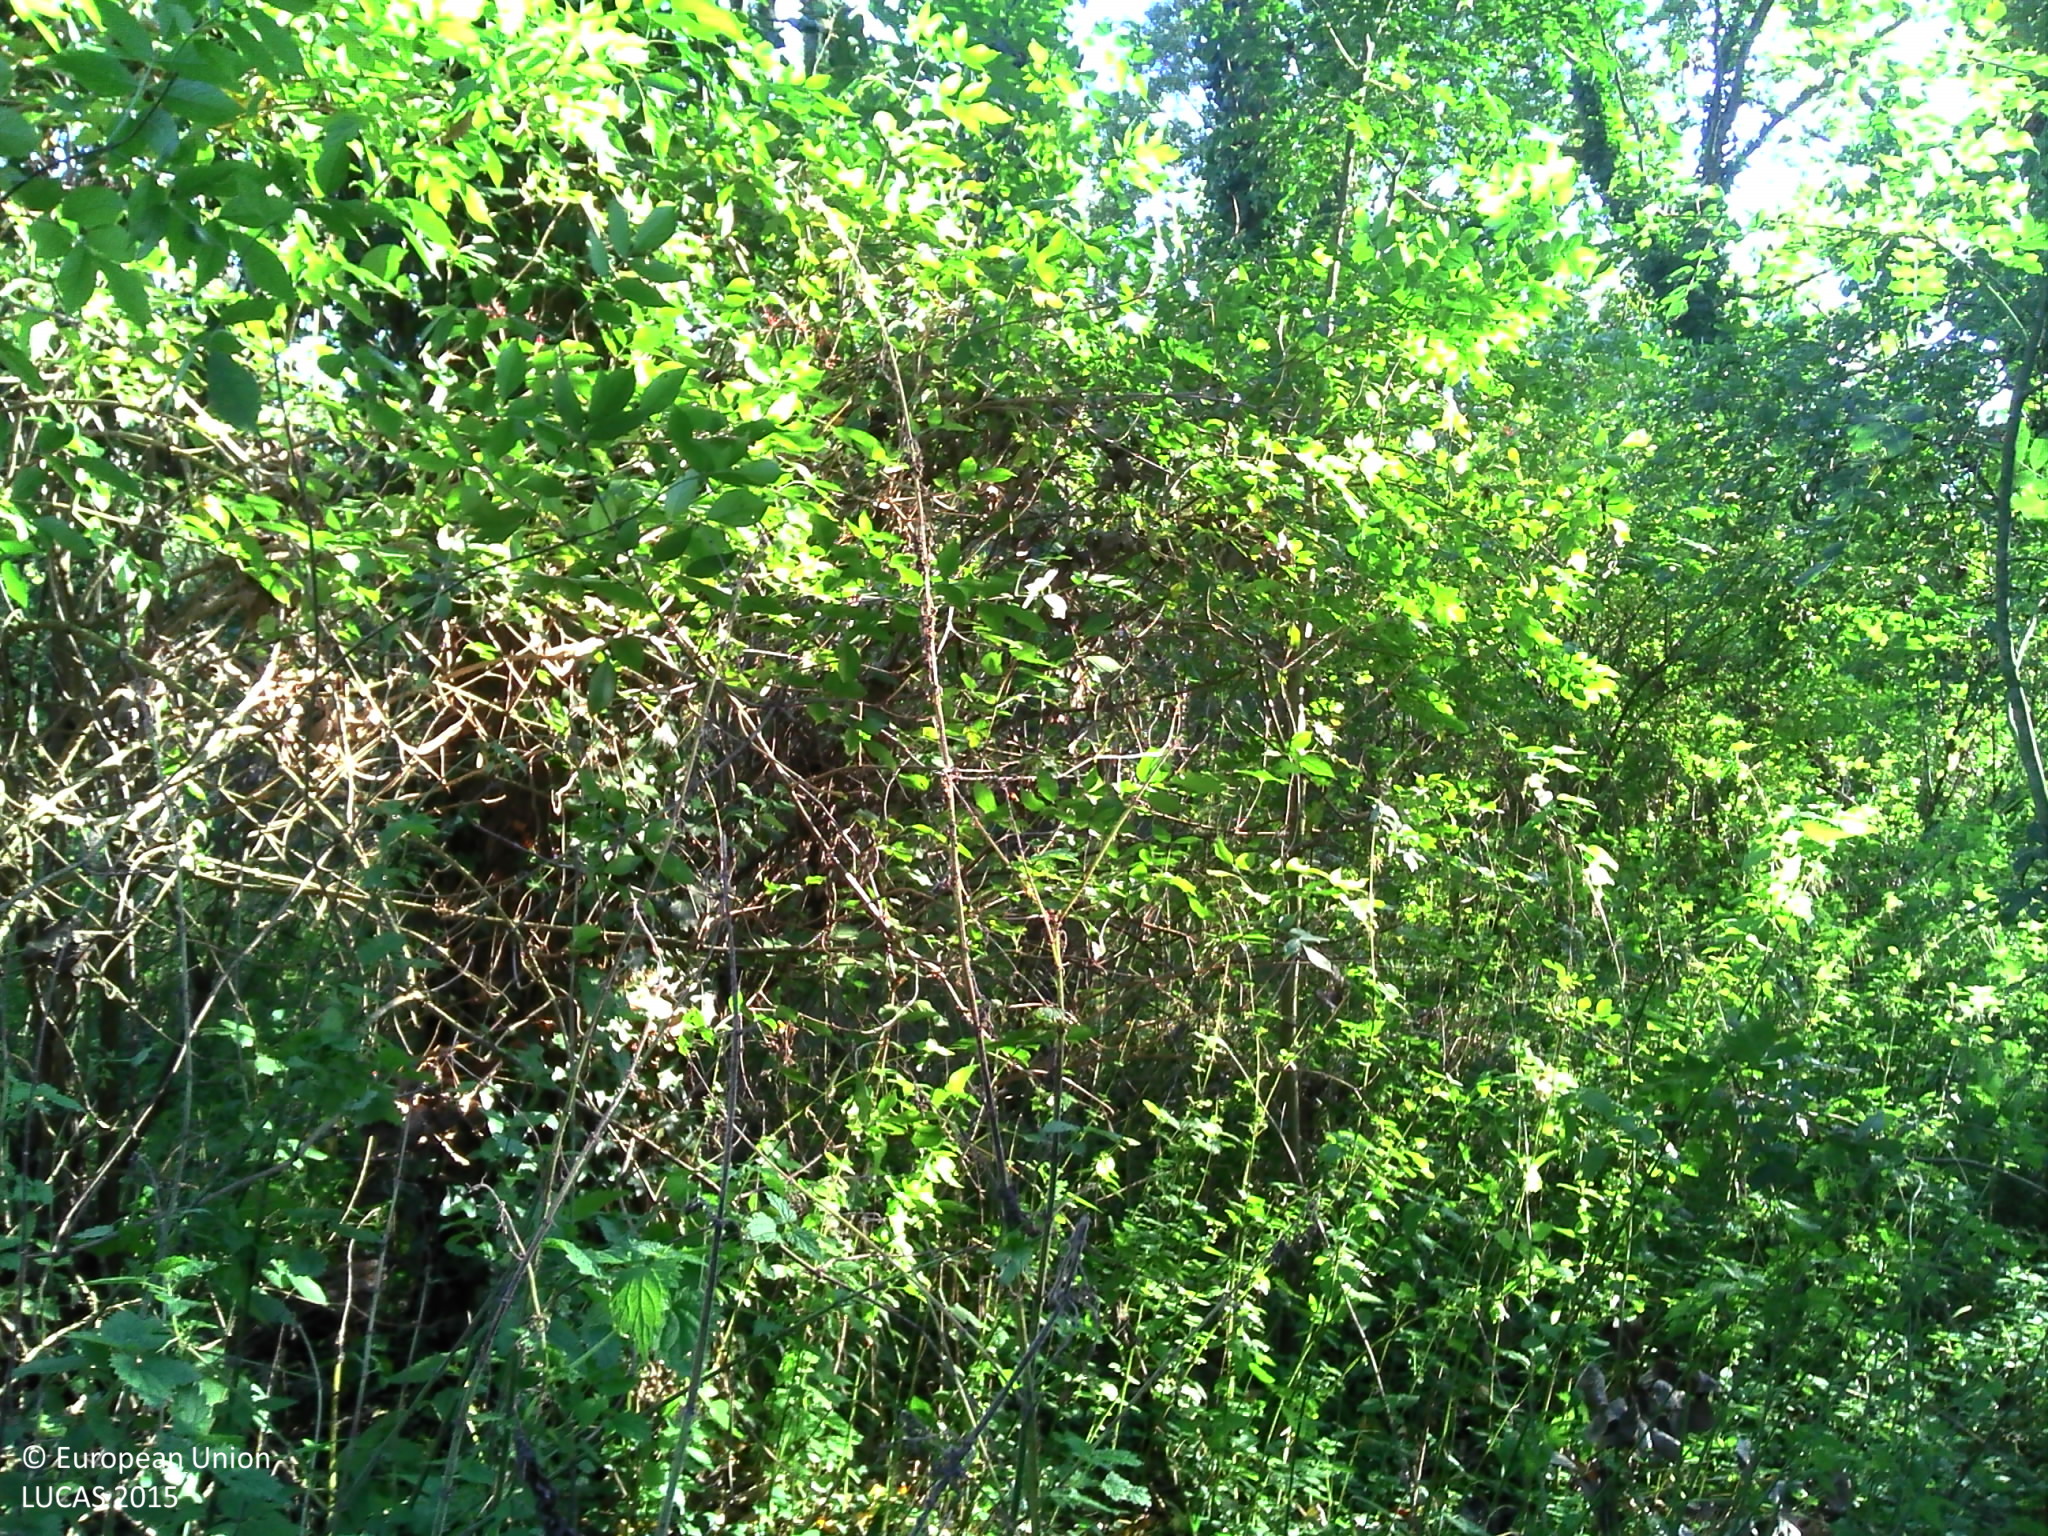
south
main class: Woodland
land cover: Broadleaved woodland
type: floodplain forest
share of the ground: 50 - 75 %
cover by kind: broadleaved forest trees 70 %, herbaceous plants 30 %
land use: Semi-natural and natural areas not in use
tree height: > 5 m
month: September
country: FR
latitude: 46.5879
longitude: -1.1141
